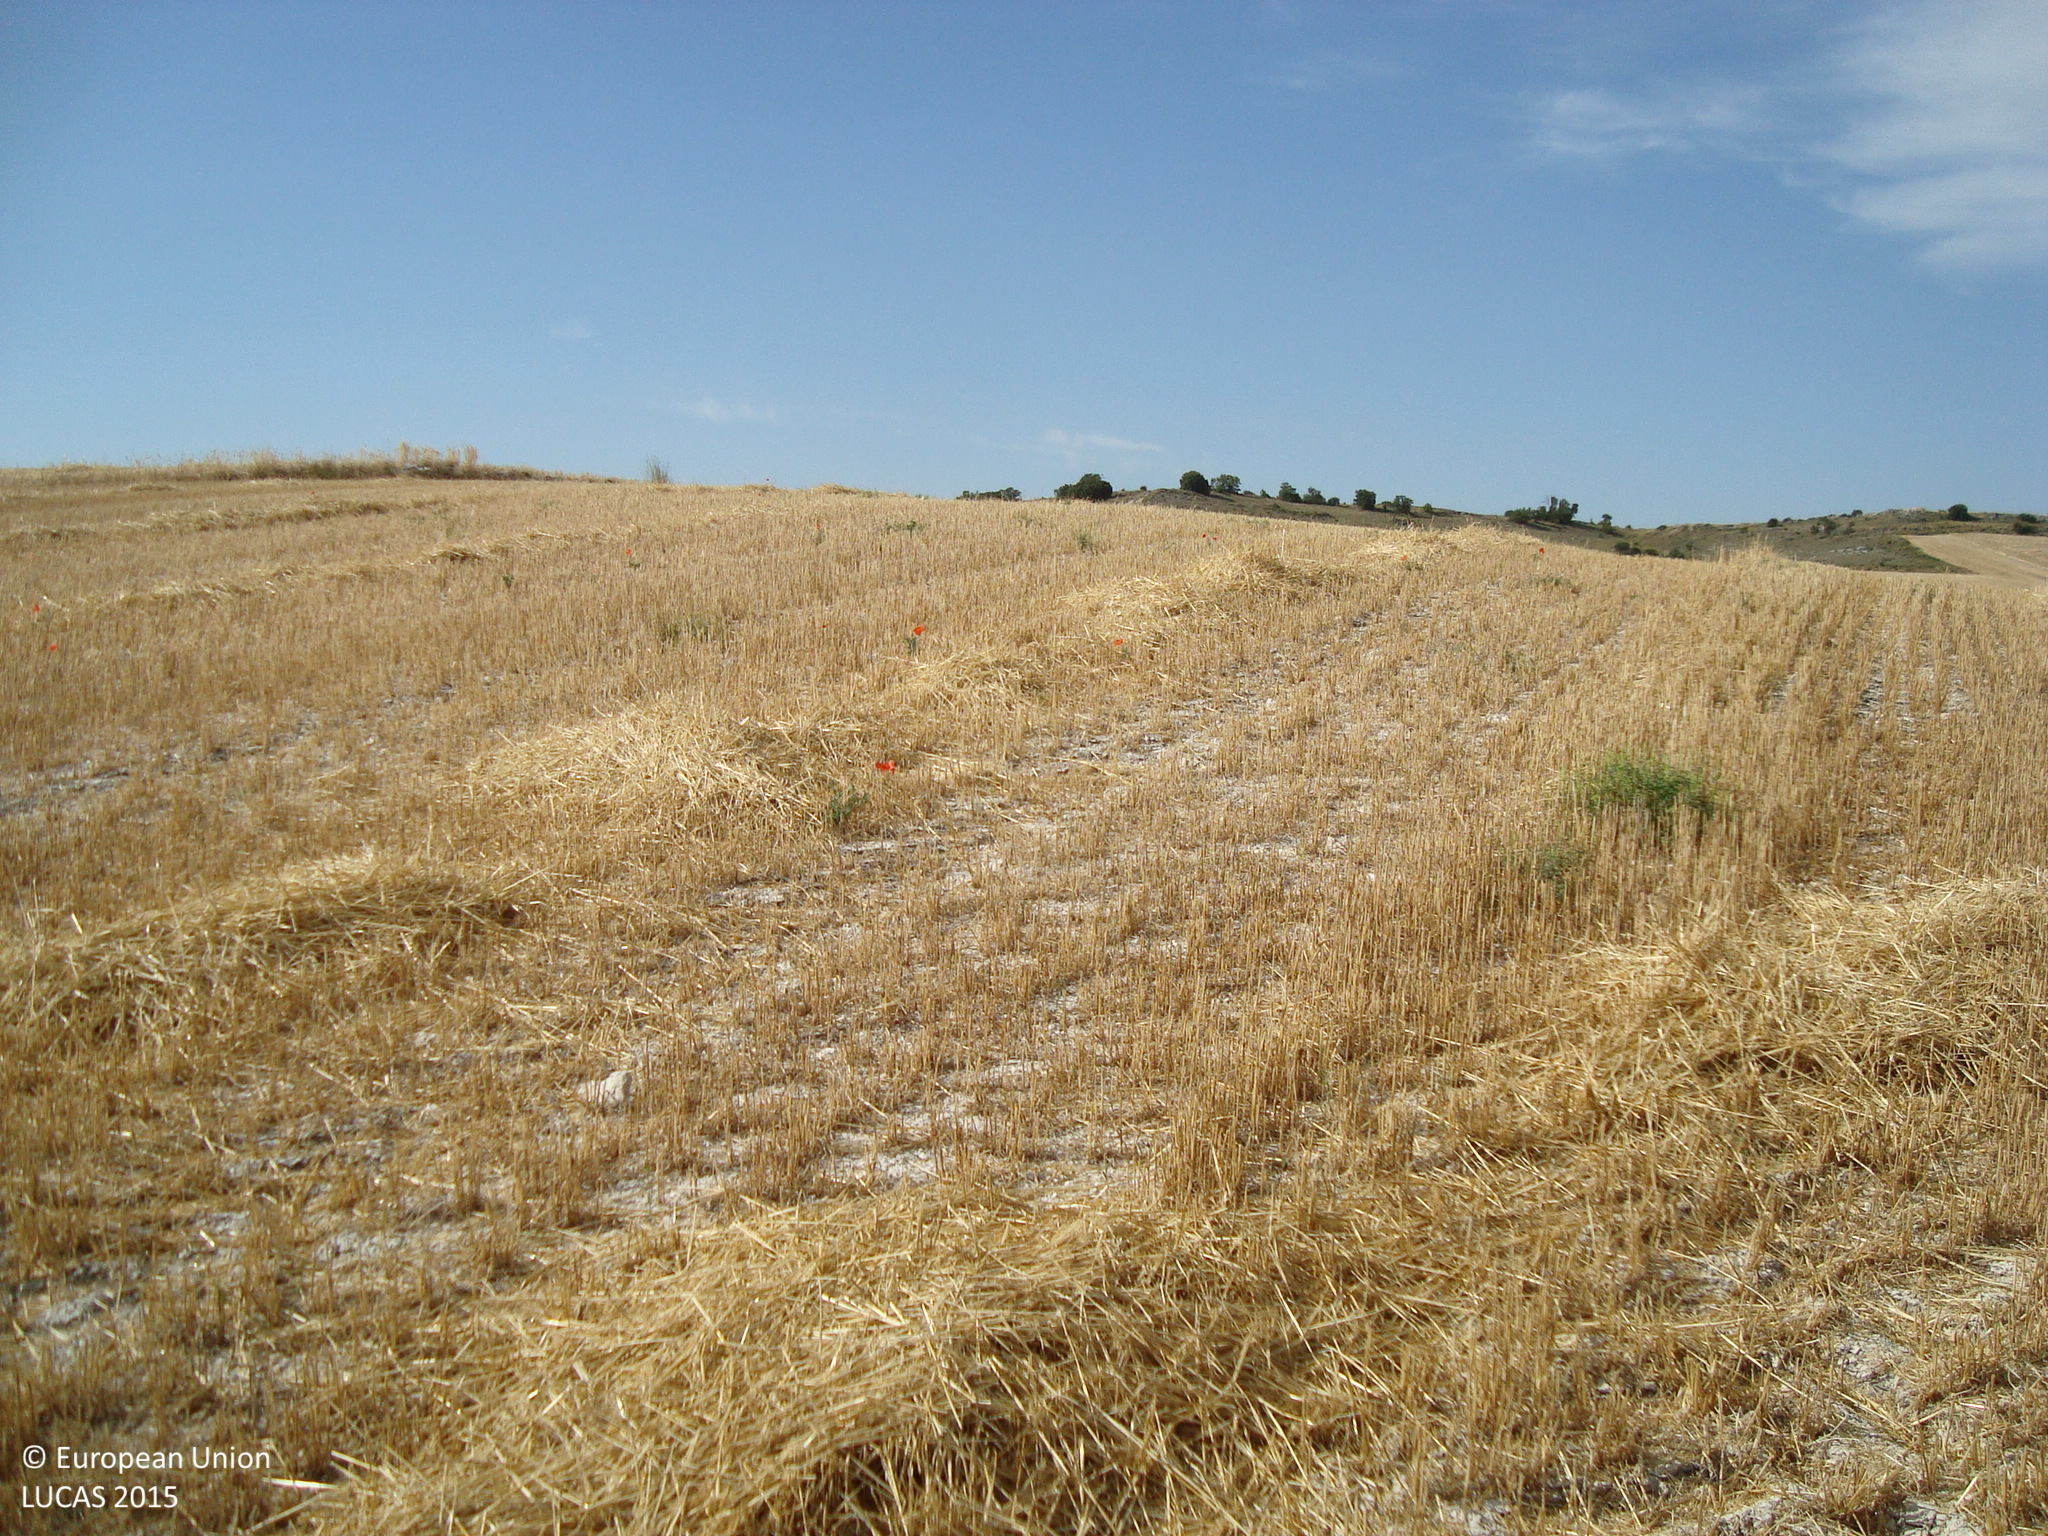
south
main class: Cropland
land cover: Barley
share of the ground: > 75 %
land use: Agriculture (excluding fallow land and kitchen gardens)
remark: Harvested field
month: July
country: ES
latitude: 41.9213
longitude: -4.2077
